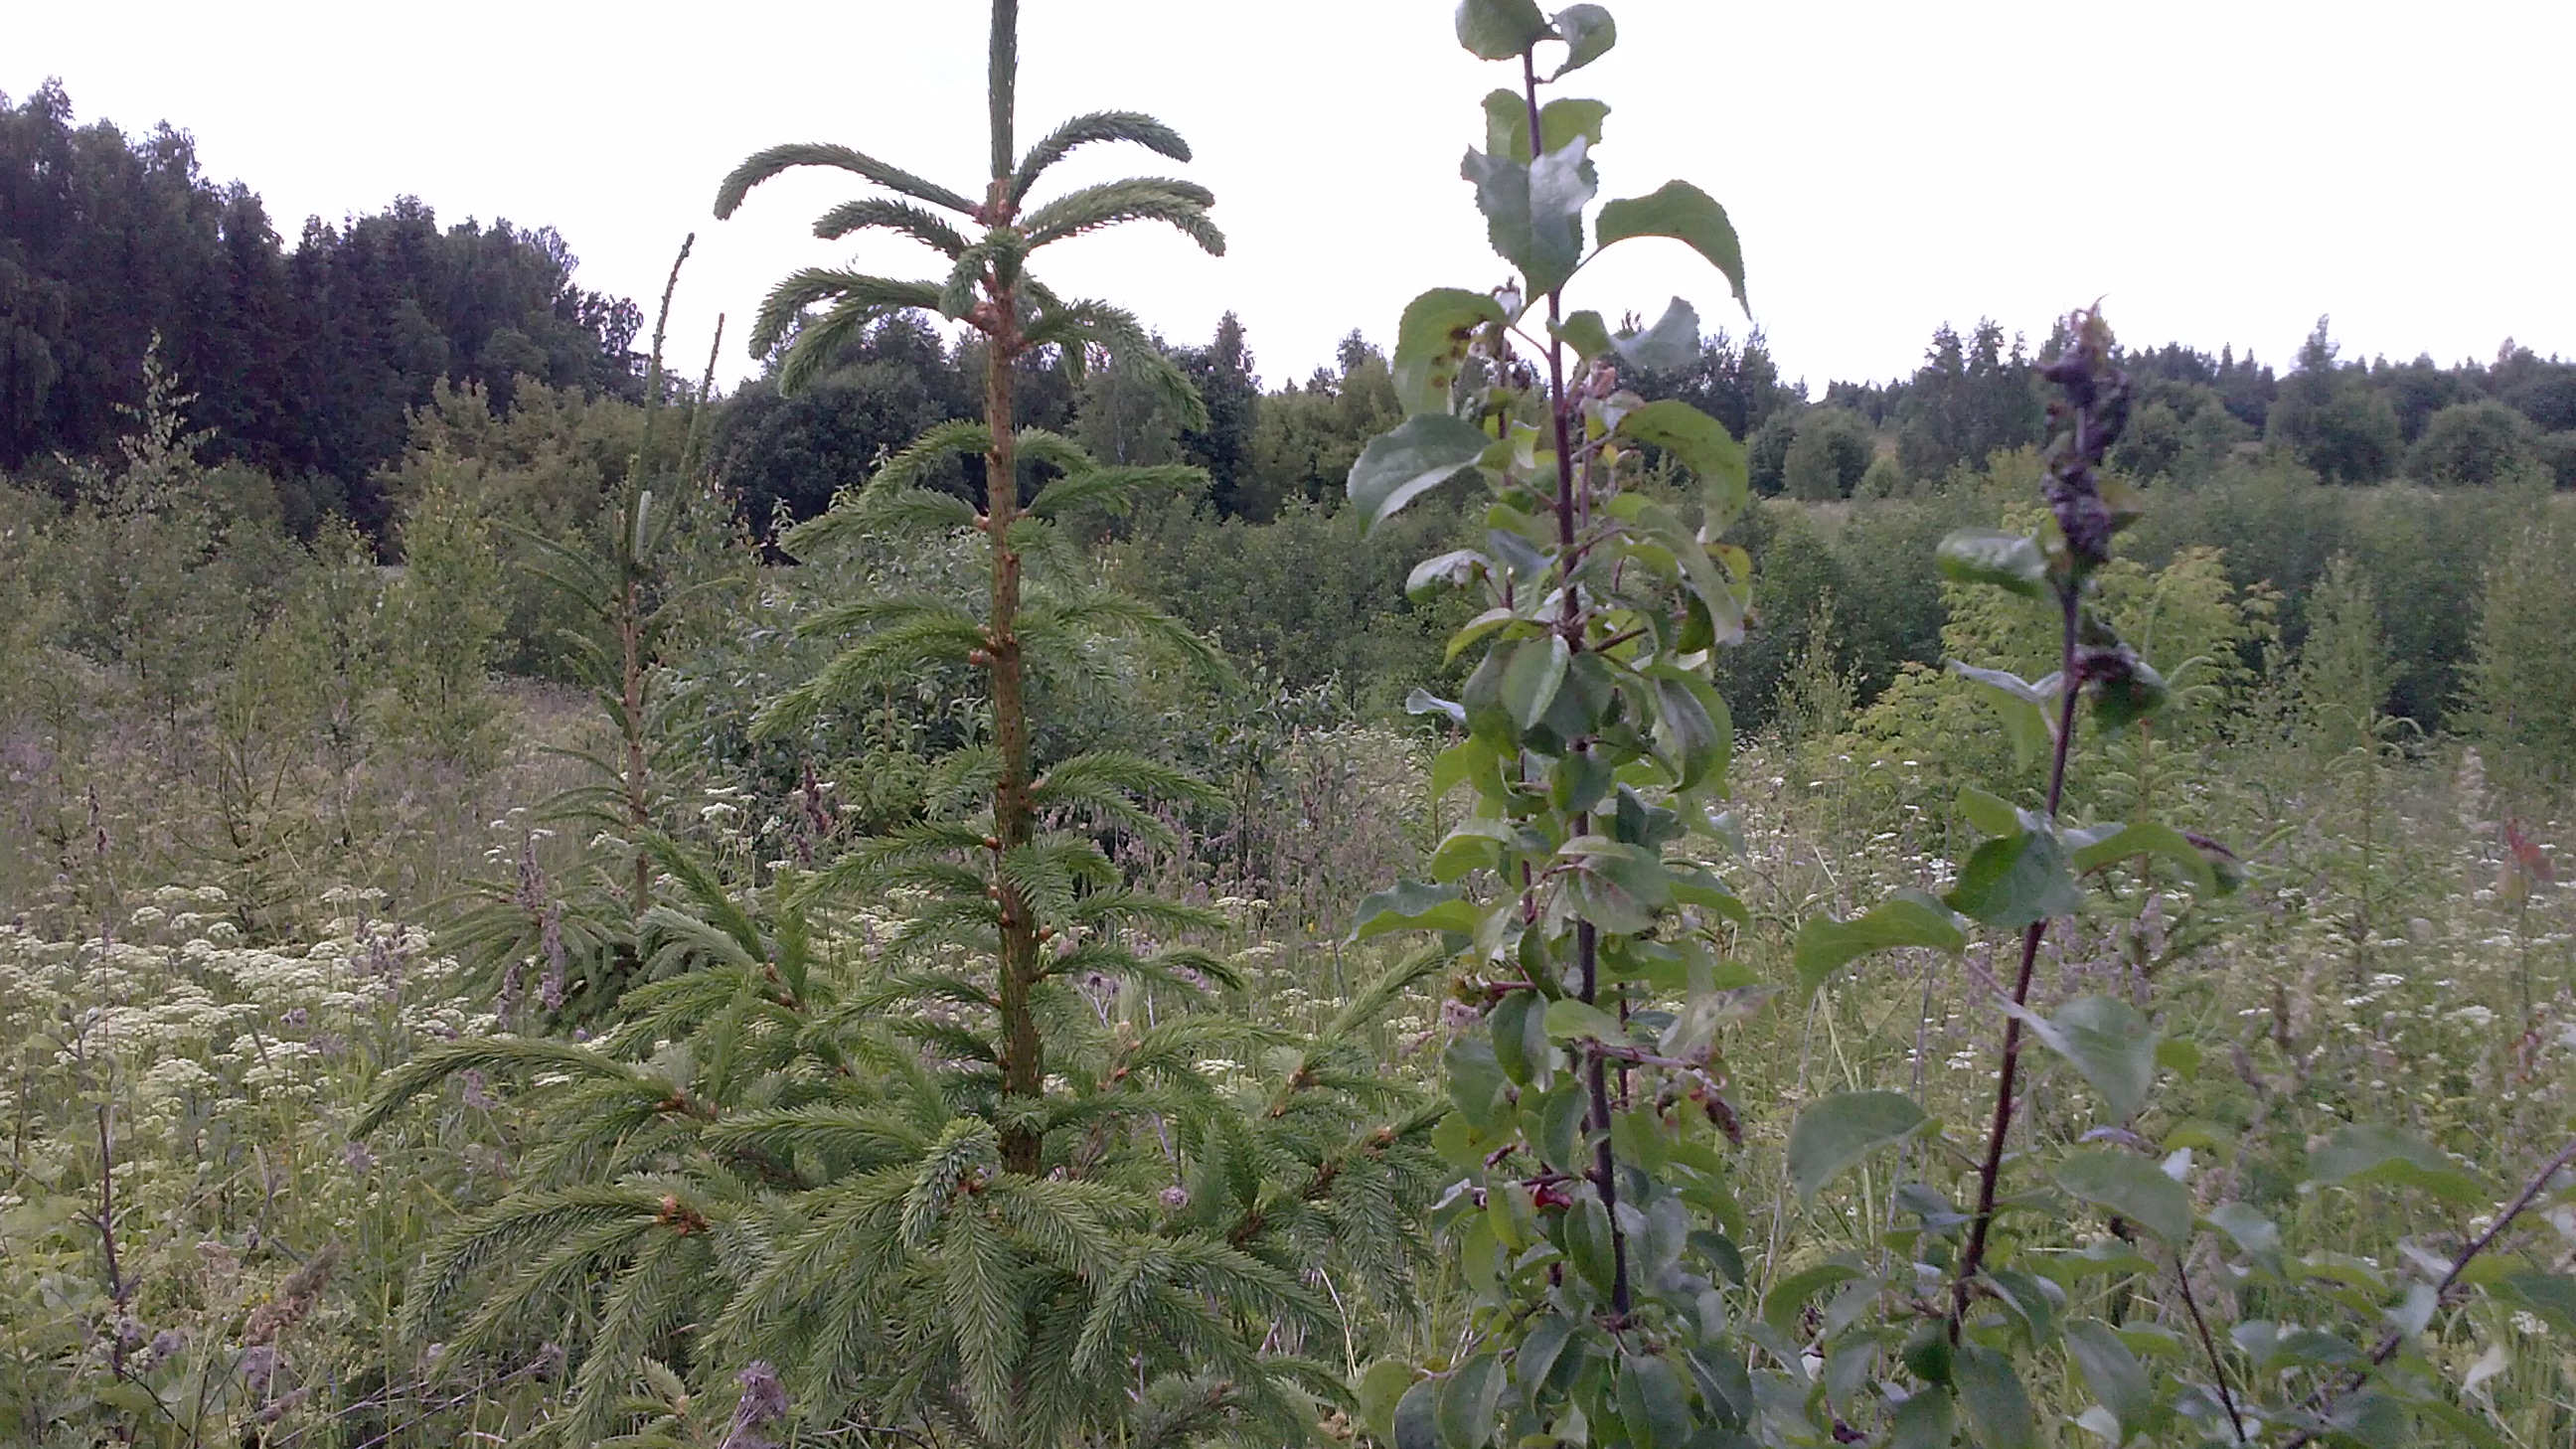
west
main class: Grassland
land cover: Grassland with sparse tree/shrub cover
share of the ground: > 75 %
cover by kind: herbaceous plants 90 %, coniferous forest trees 5 %, shrubs 5 %
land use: Forestry
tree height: < 5 m
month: June
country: LV
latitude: 56.5043
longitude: 27.8856
